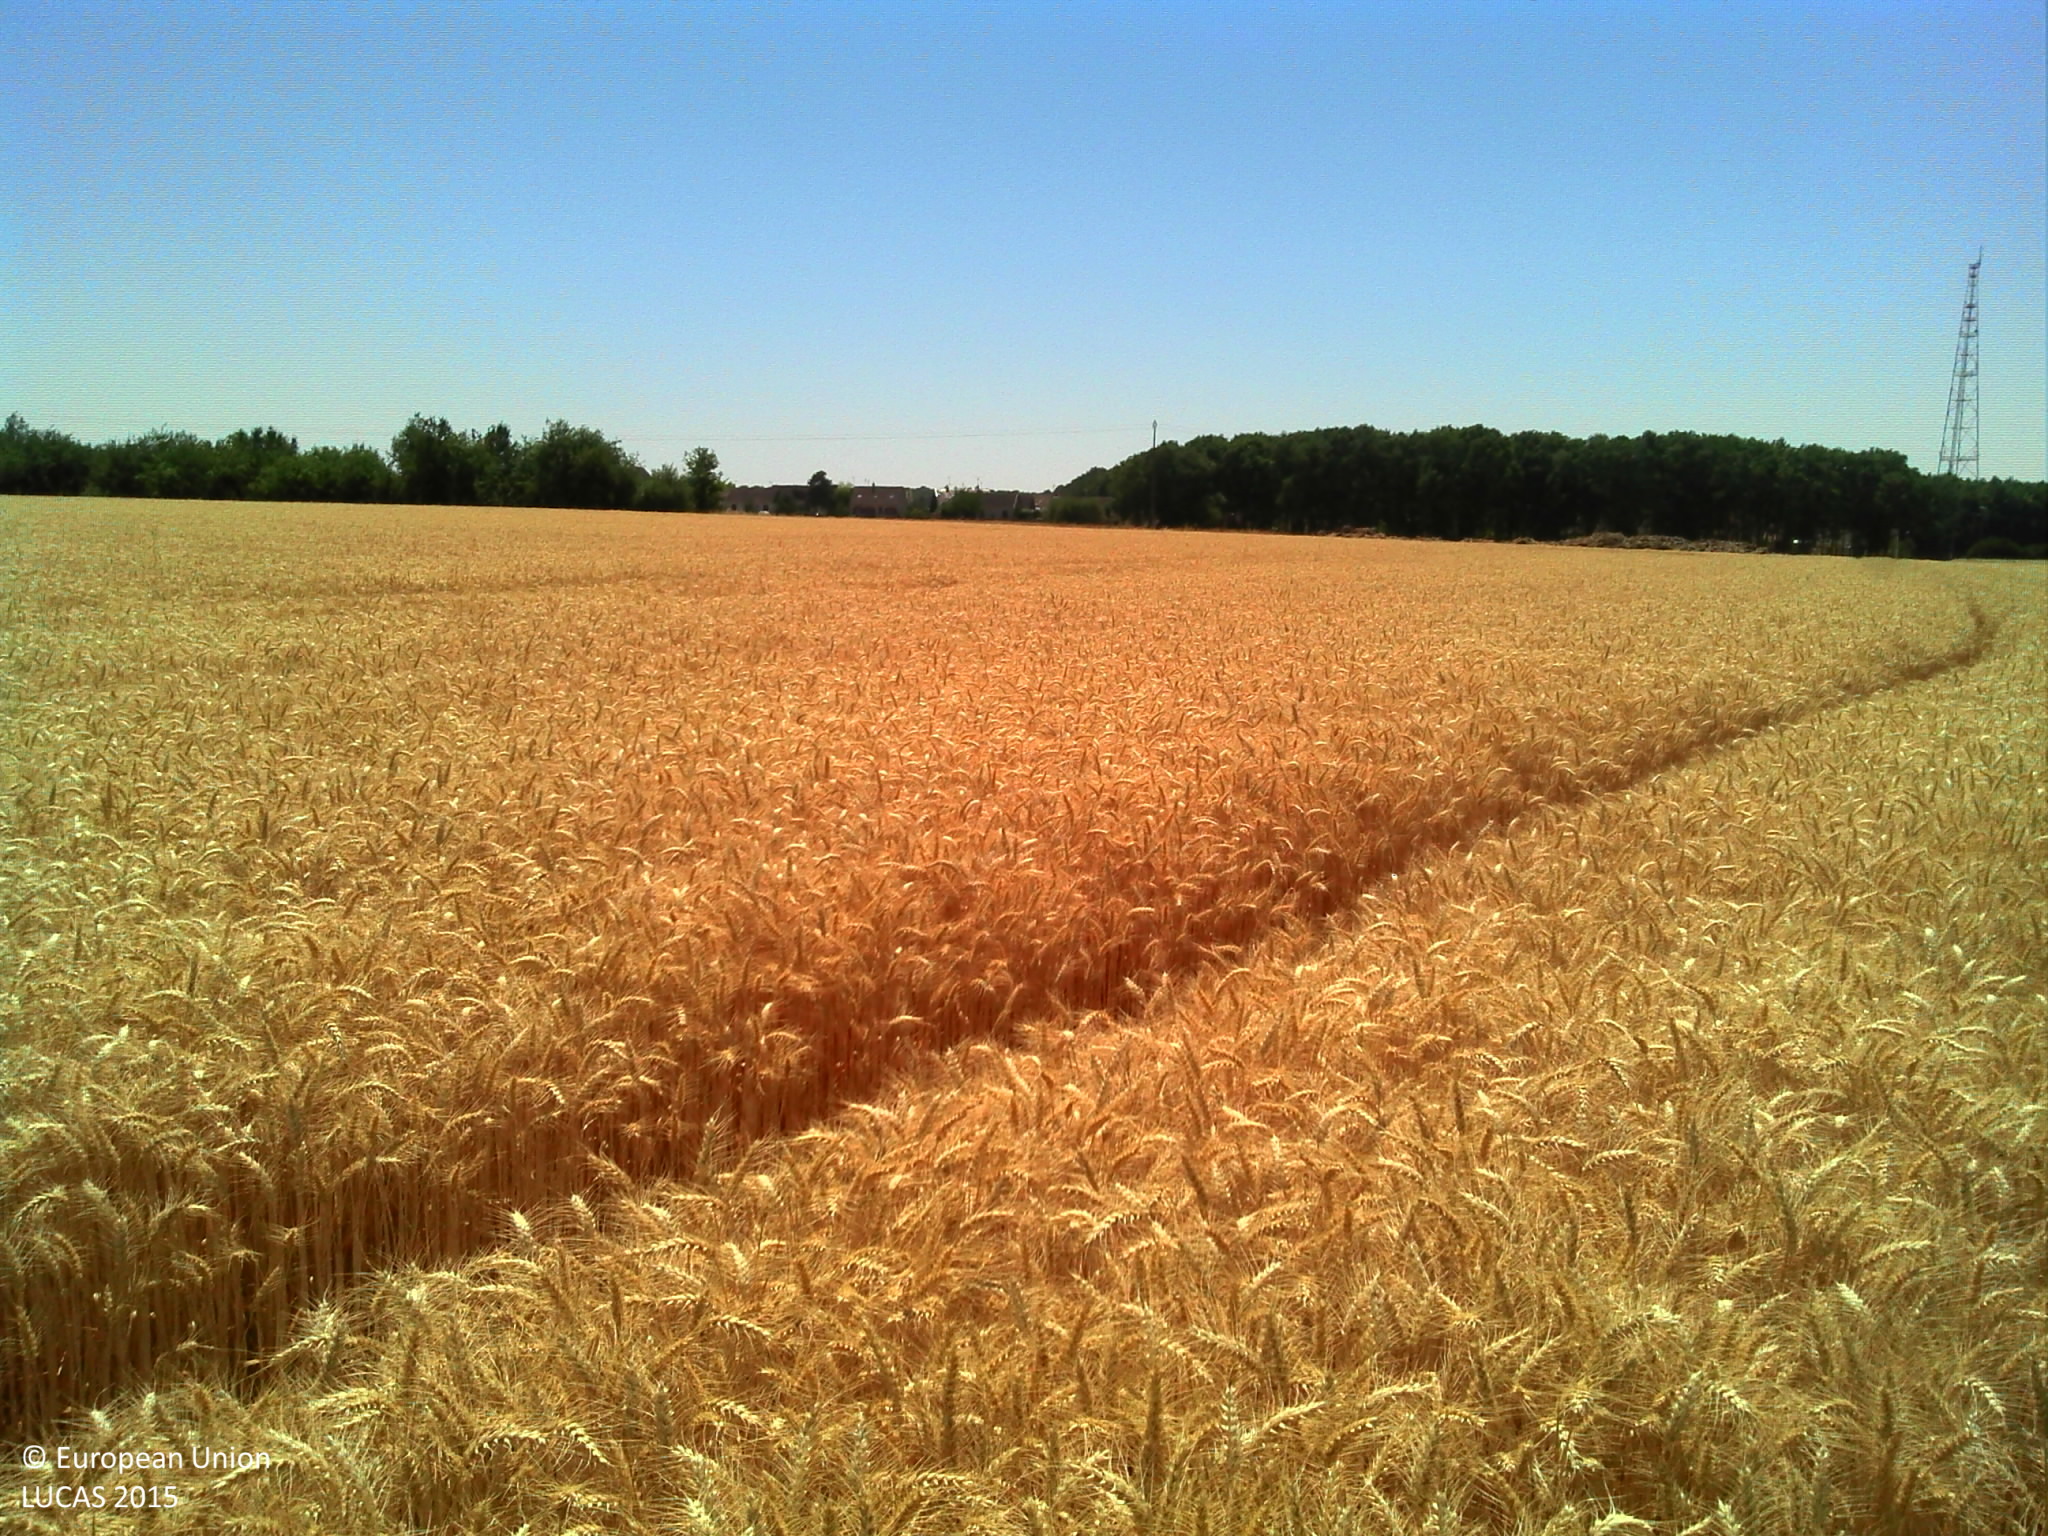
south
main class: Cropland
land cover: Common wheat
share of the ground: > 75 %
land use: Agriculture (excluding fallow land and kitchen gardens)
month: July
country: FR
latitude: 48.0423
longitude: 1.3044
